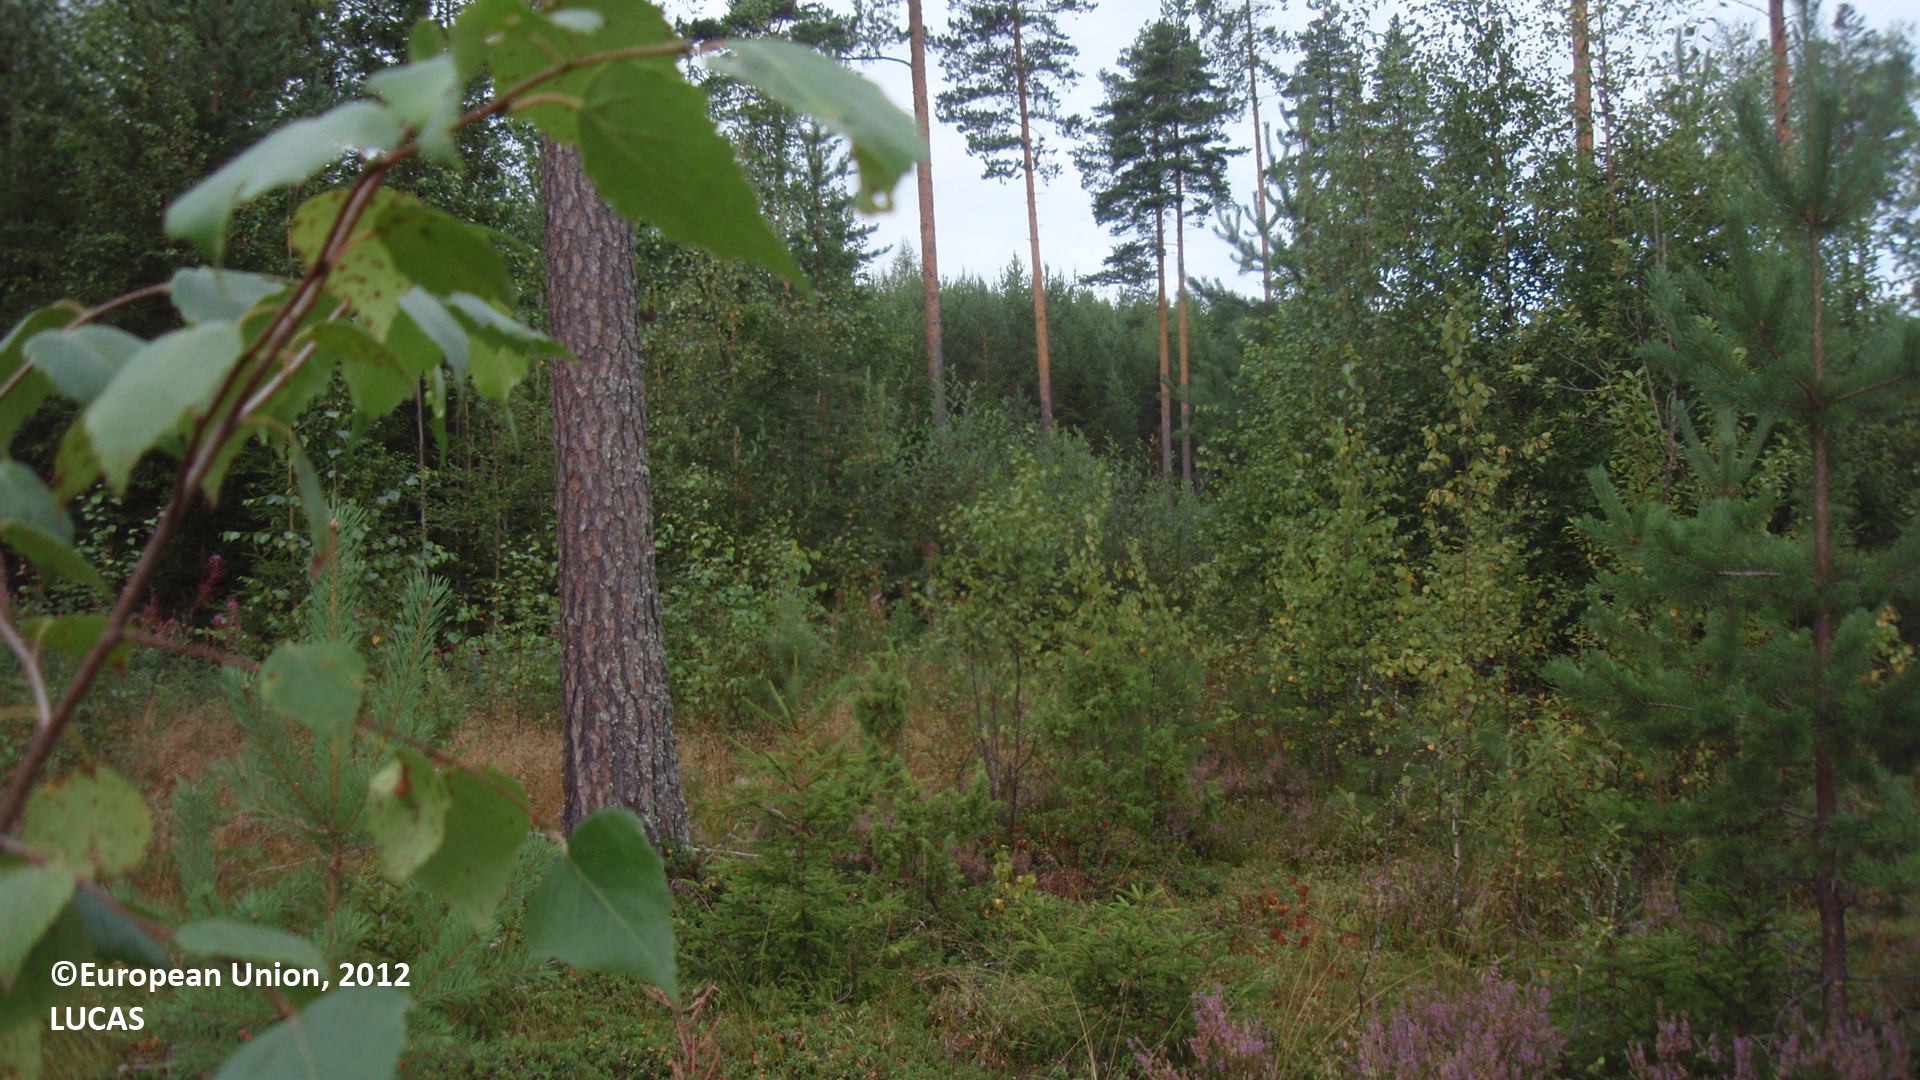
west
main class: Grassland
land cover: Grassland with sparse tree/shrub cover
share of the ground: 25 - 50 %
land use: Forestry
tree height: < 5 m
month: August
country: FI
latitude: 61.0853
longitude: 27.4025
